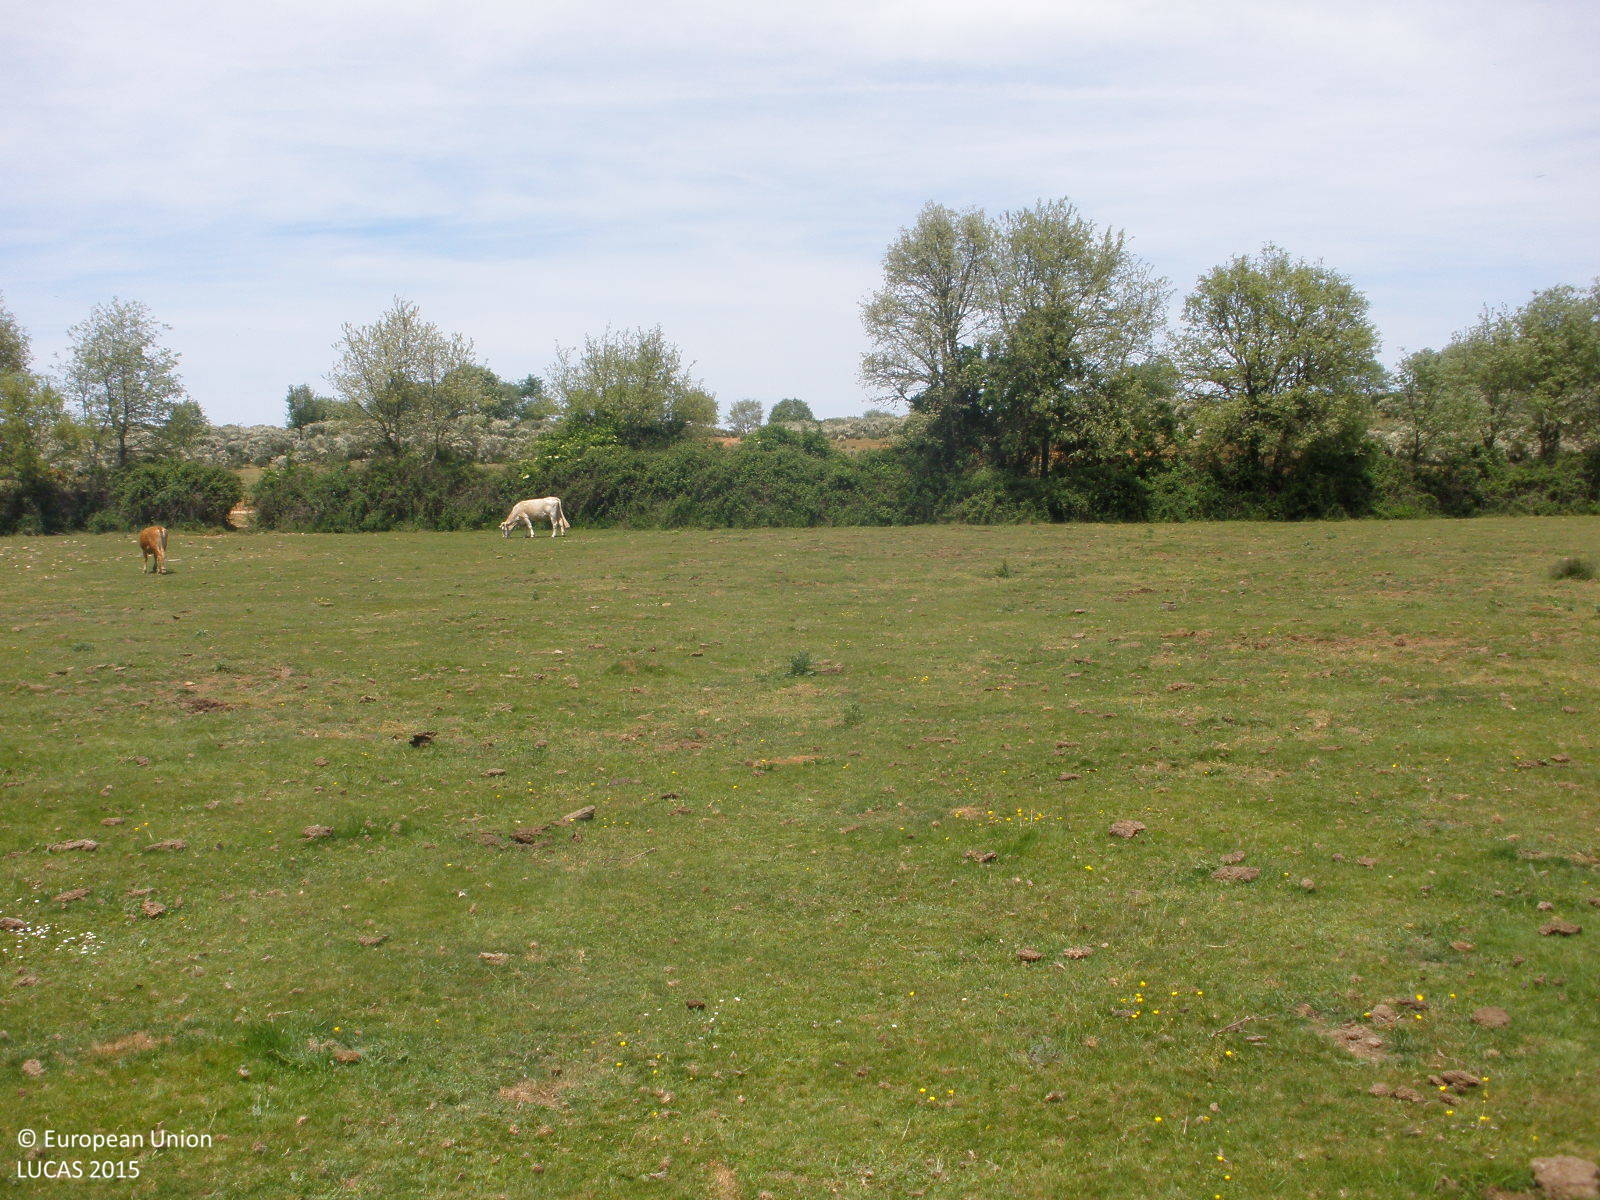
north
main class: Grassland
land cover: Grassland without tree/shrub cover
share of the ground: > 75 %
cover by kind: herbaceous plants 100 %
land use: Agriculture (excluding fallow land and kitchen gardens)
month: May
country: ES
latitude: 40.3300
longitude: -6.6245
